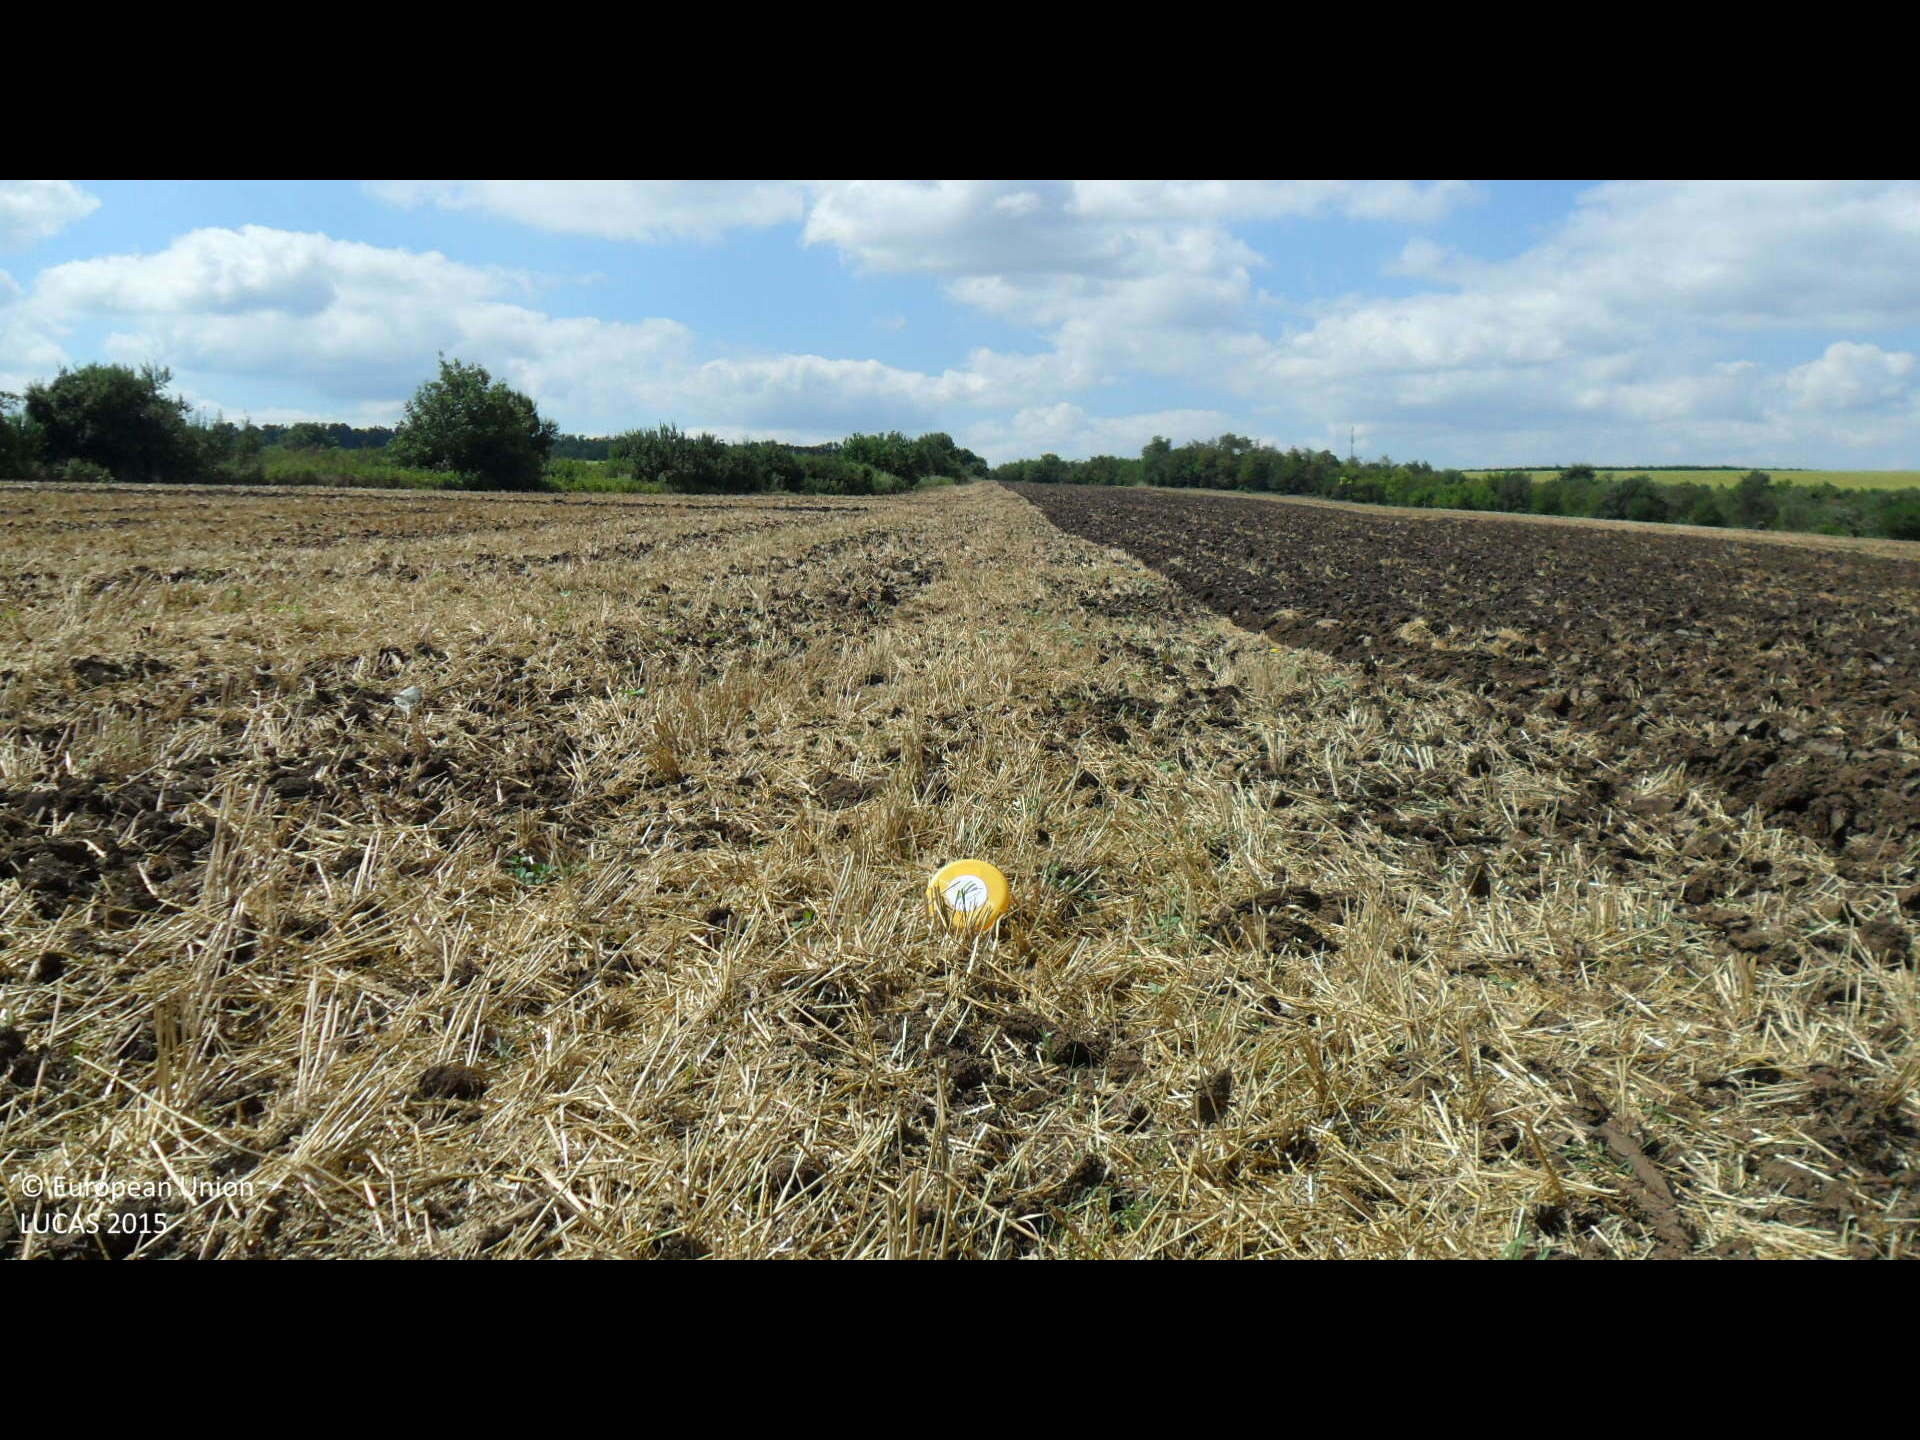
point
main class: Cropland
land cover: Common wheat
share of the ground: 25 - 50 %
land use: Agriculture (excluding fallow land and kitchen gardens)
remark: Harvested field
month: August
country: BG
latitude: 43.4435
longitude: 26.3737
